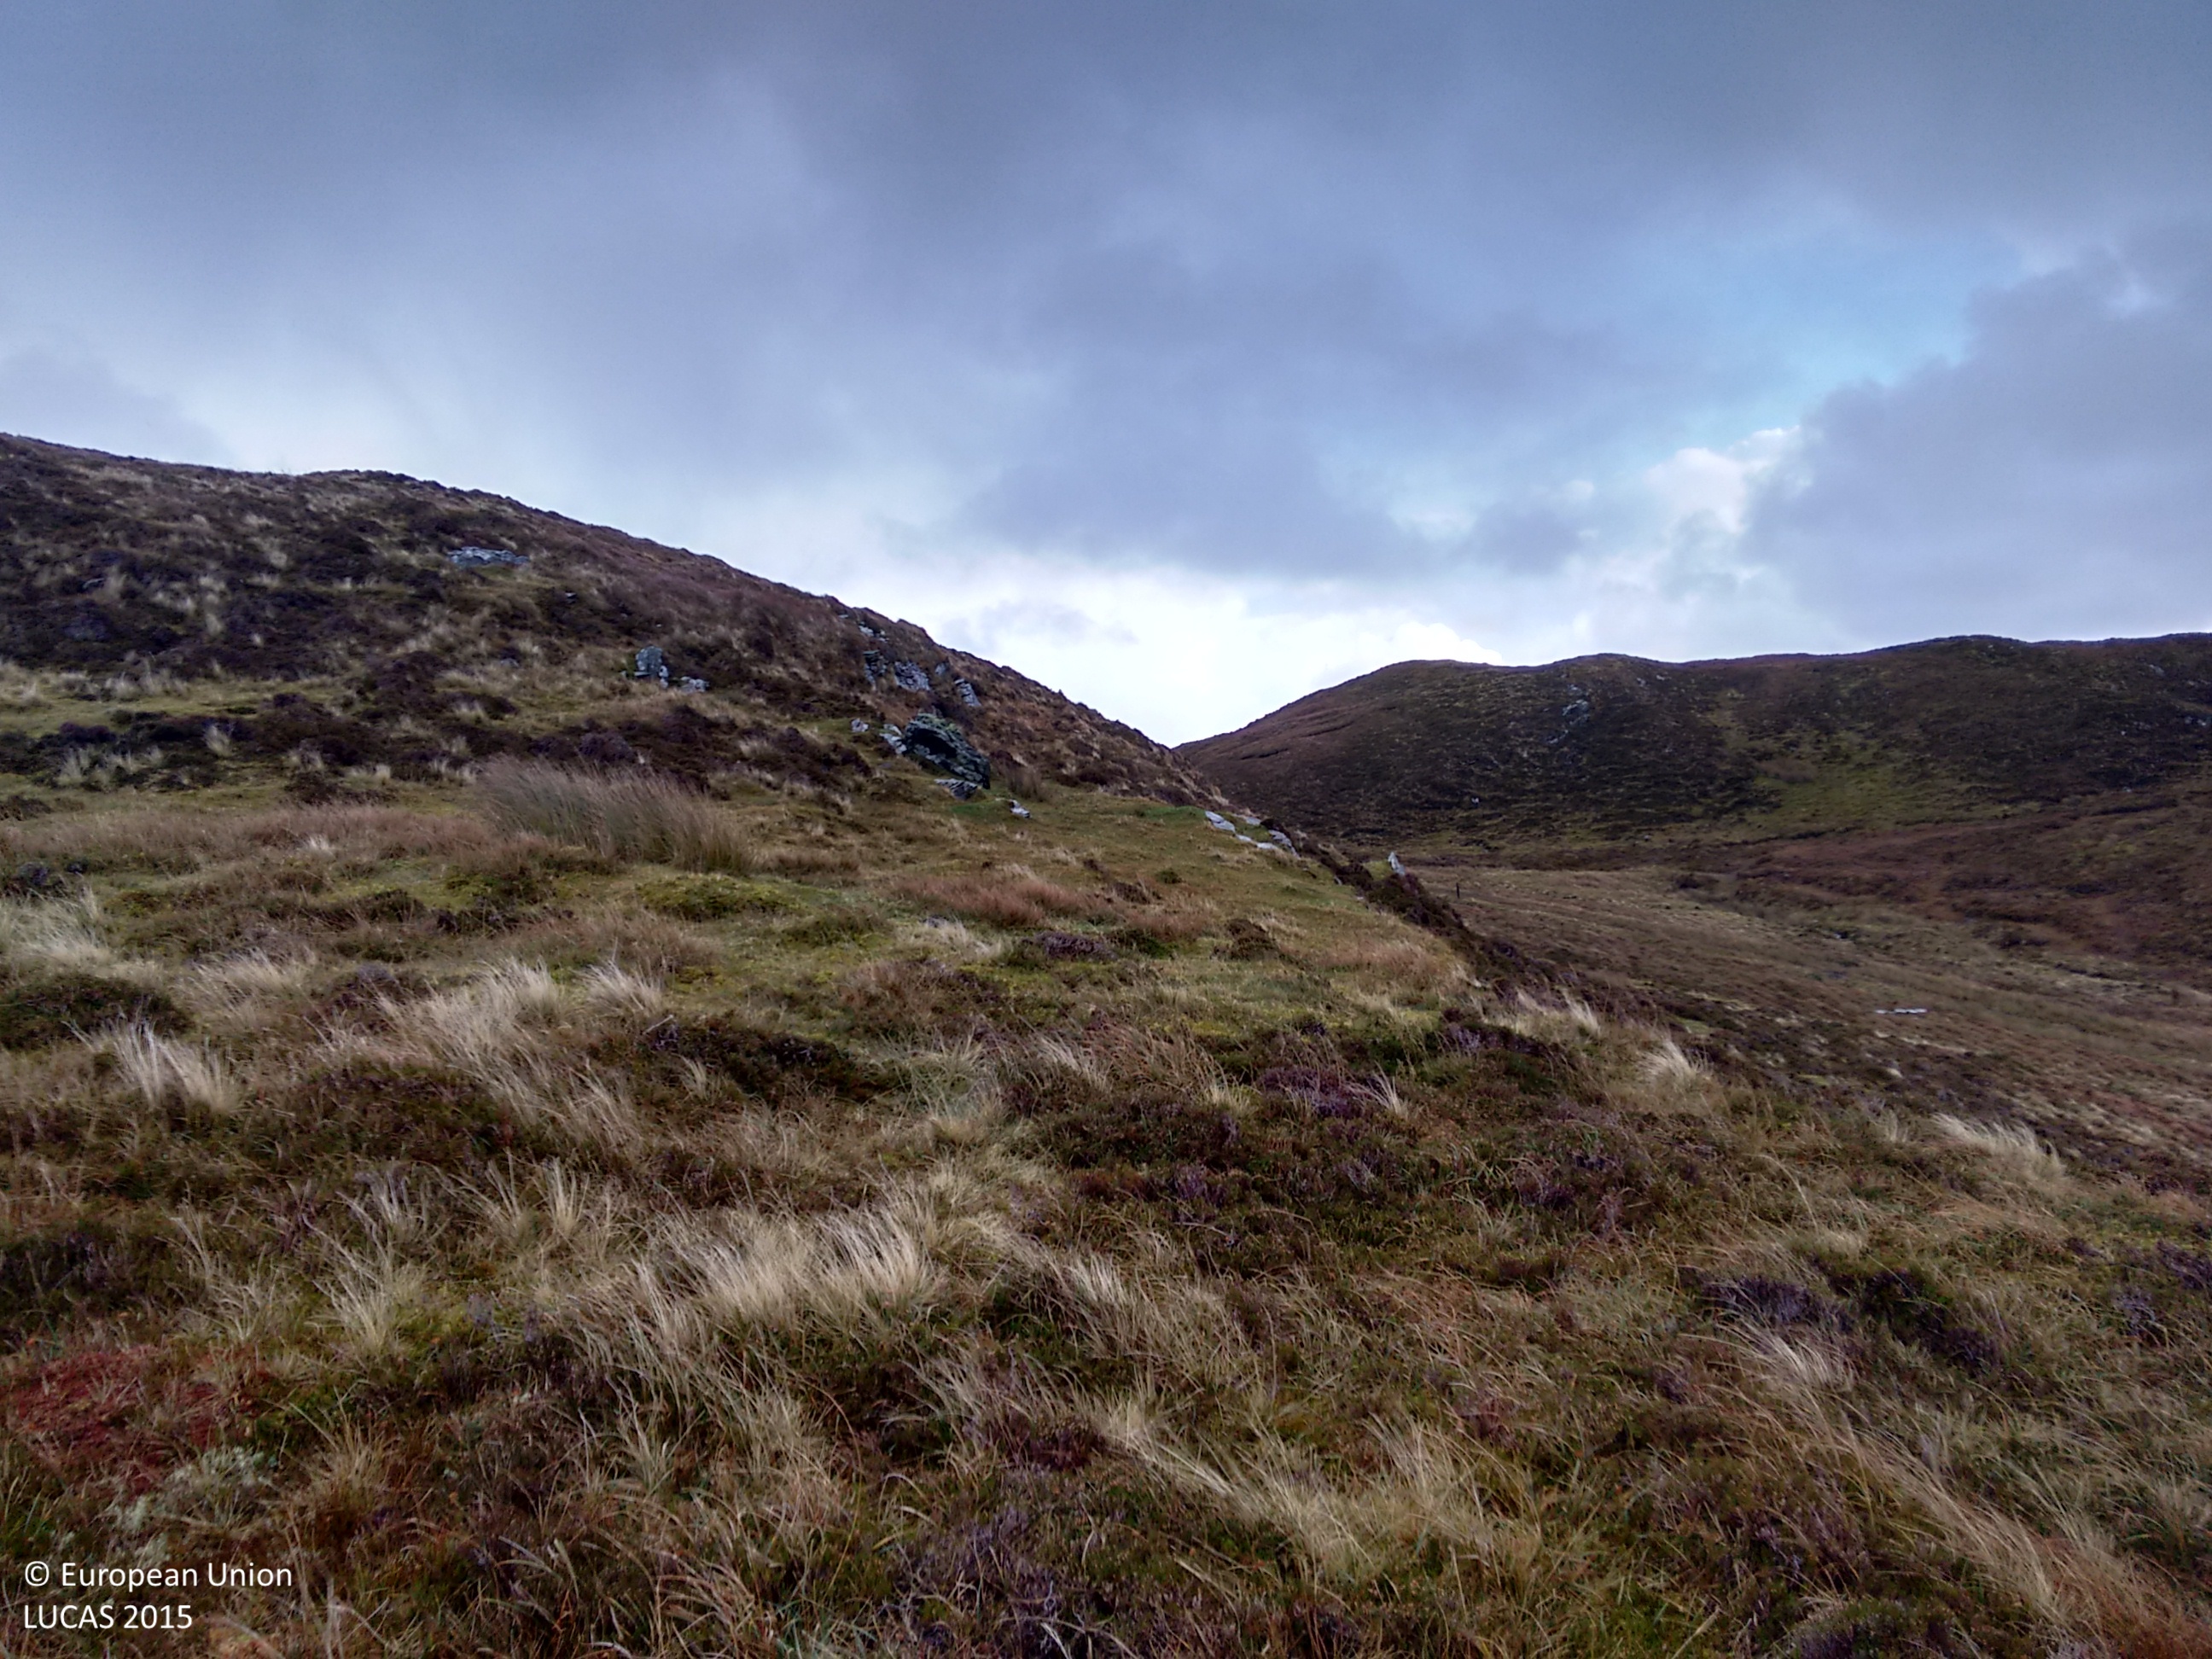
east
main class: Shrubland
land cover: Shrubland without tree cover
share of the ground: > 75 %
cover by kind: shrubs 40 %, herbaceous plants 40 %, lichens and mosses 20 %
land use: Agriculture (excluding fallow land and kitchen gardens)
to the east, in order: Shrubland without tree cover; Peatbogs
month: November
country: IE
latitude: 54.6990
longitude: -8.7102
